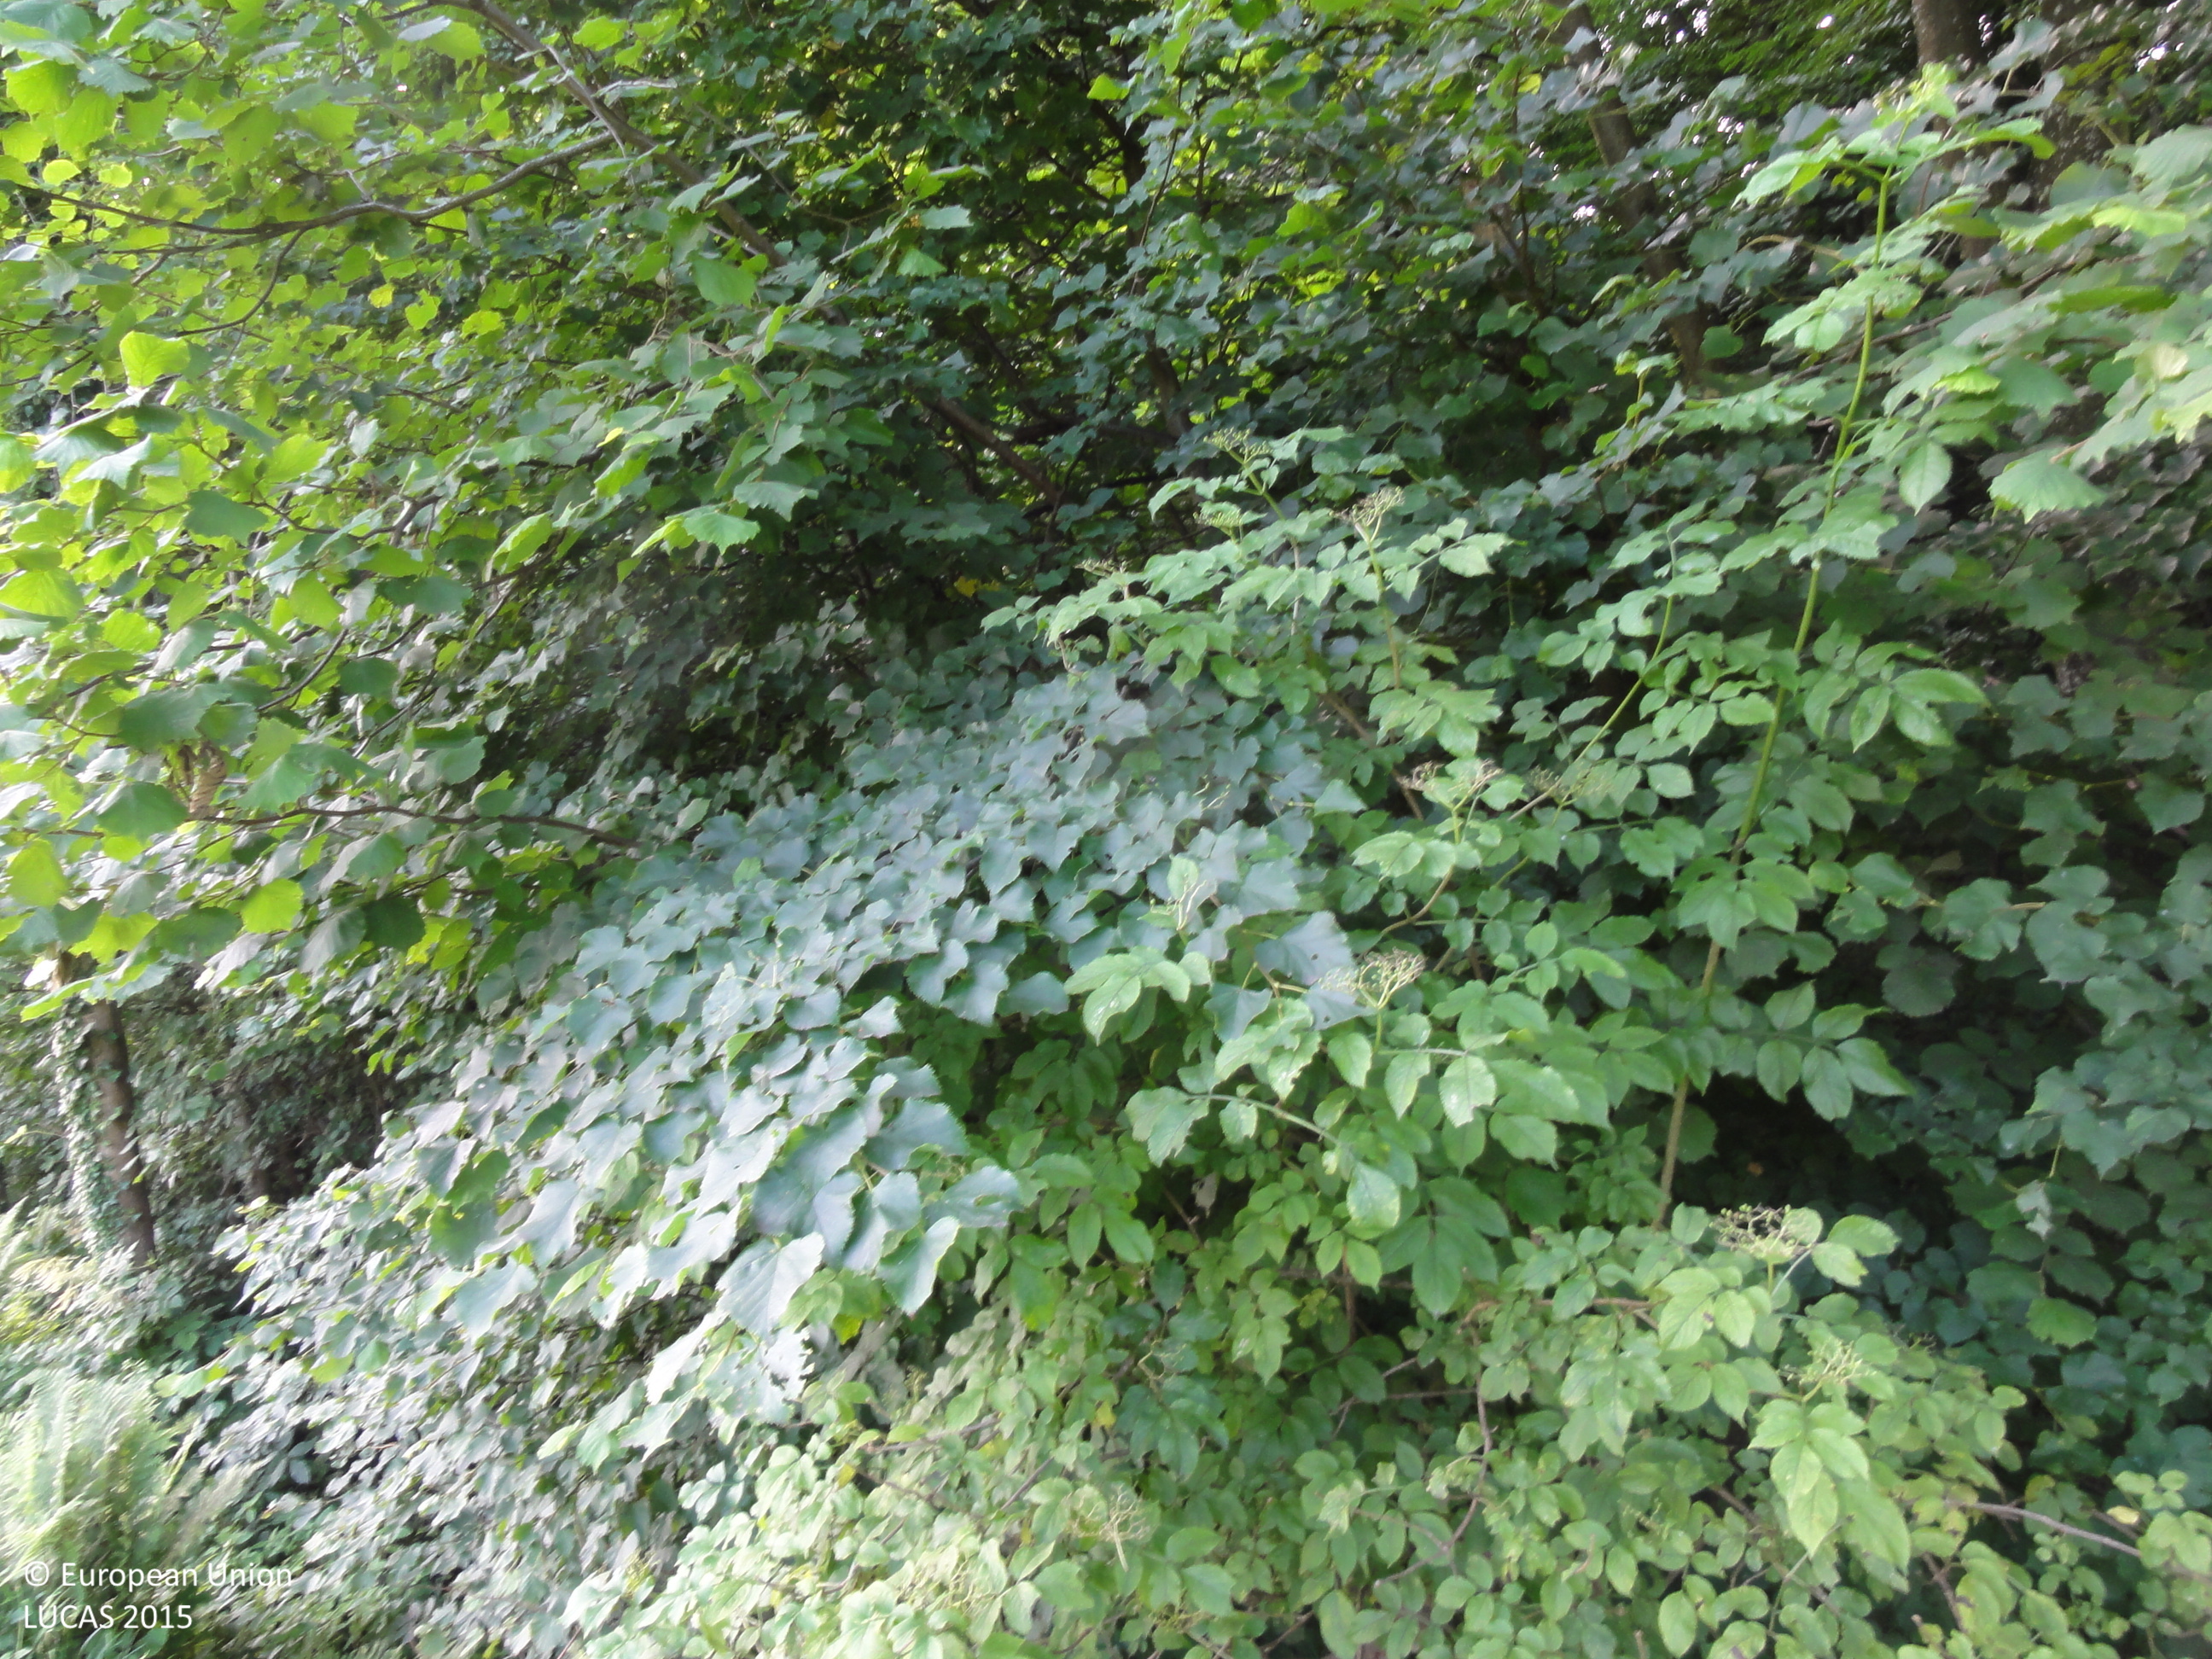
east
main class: Shrubland
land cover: Shrubland with sparse tree cover
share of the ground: > 75 %
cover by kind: shrubs 95 %, broadleaved forest trees 5 %
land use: Forestry
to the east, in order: Shrubland with sparse tree cover; Spruce dominated mixed woodland; Rivers and streams; Spruce dominated mixed woodland; Tracks; Spruce dominated mixed woodland; Grass margins; Maize; Grass margins; Broadleaved woodland; Spruce dominated mixed woodland; Grass margins; Paved roads, cycling and walking lanes; Grassland without tree/shrub cover; Single bushes/trees
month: July
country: SI
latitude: 46.6223
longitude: 15.5494
